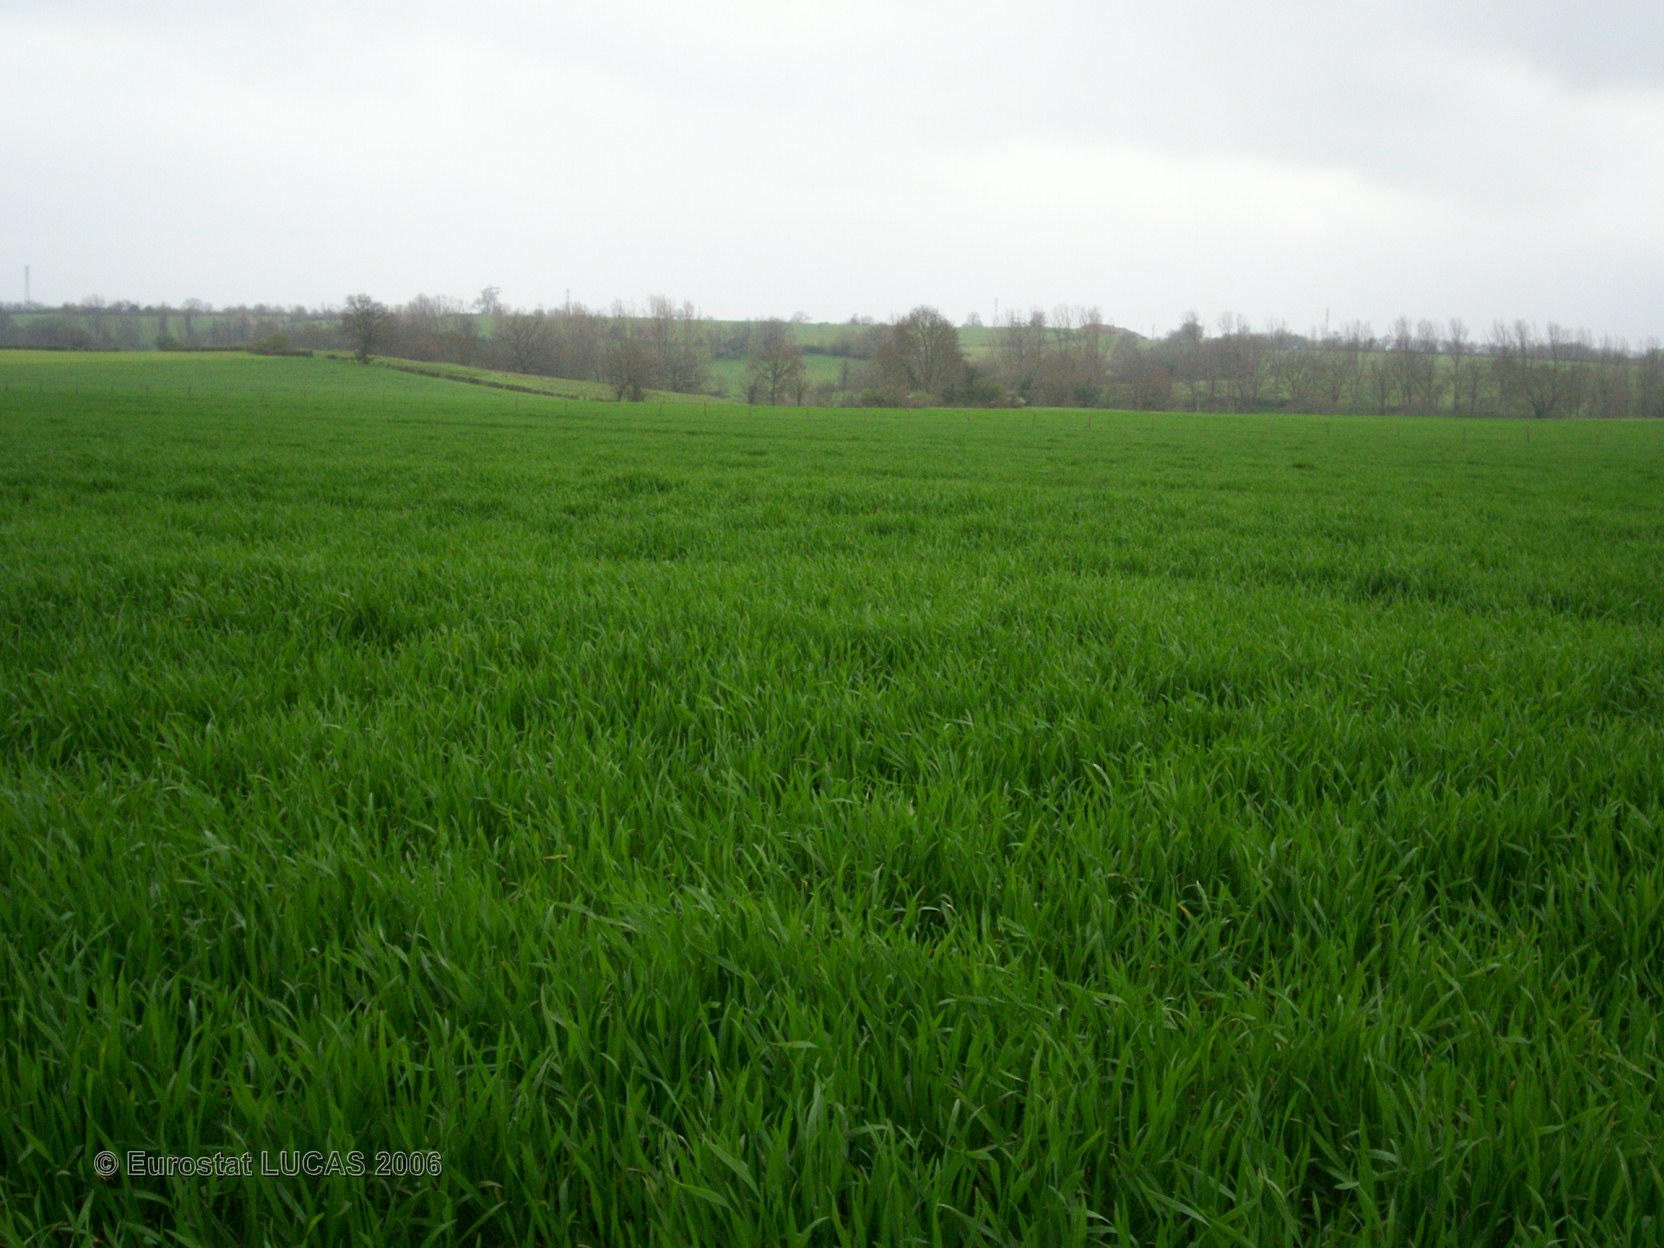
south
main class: Cropland
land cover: Common wheat
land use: Agriculture (excluding fallow land and kitchen gardens)
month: April
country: FR
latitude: 46.8488
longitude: -0.3210
